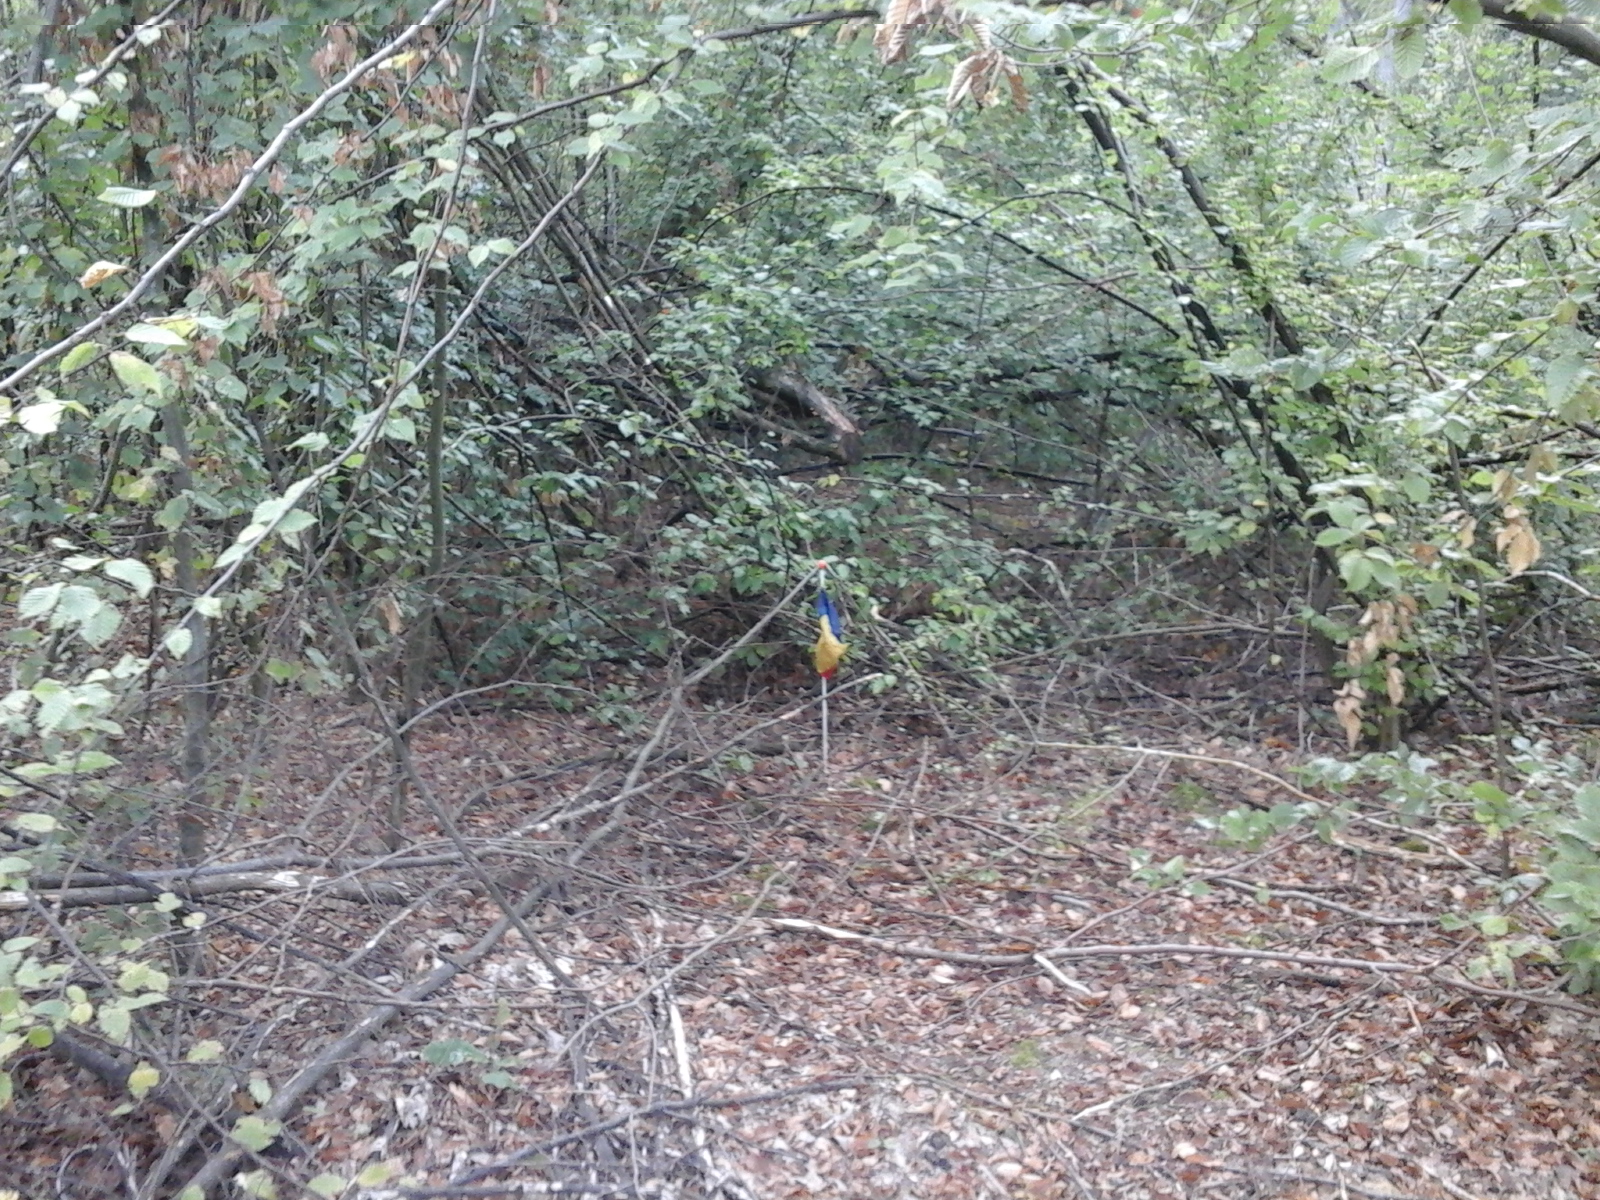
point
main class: Woodland
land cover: Broadleaved woodland
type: beech forest
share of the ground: > 75 %
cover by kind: broadleaved forest trees 100 %
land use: Forestry
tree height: > 5 m
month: September
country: RO
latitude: 47.2697
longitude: 22.5203
